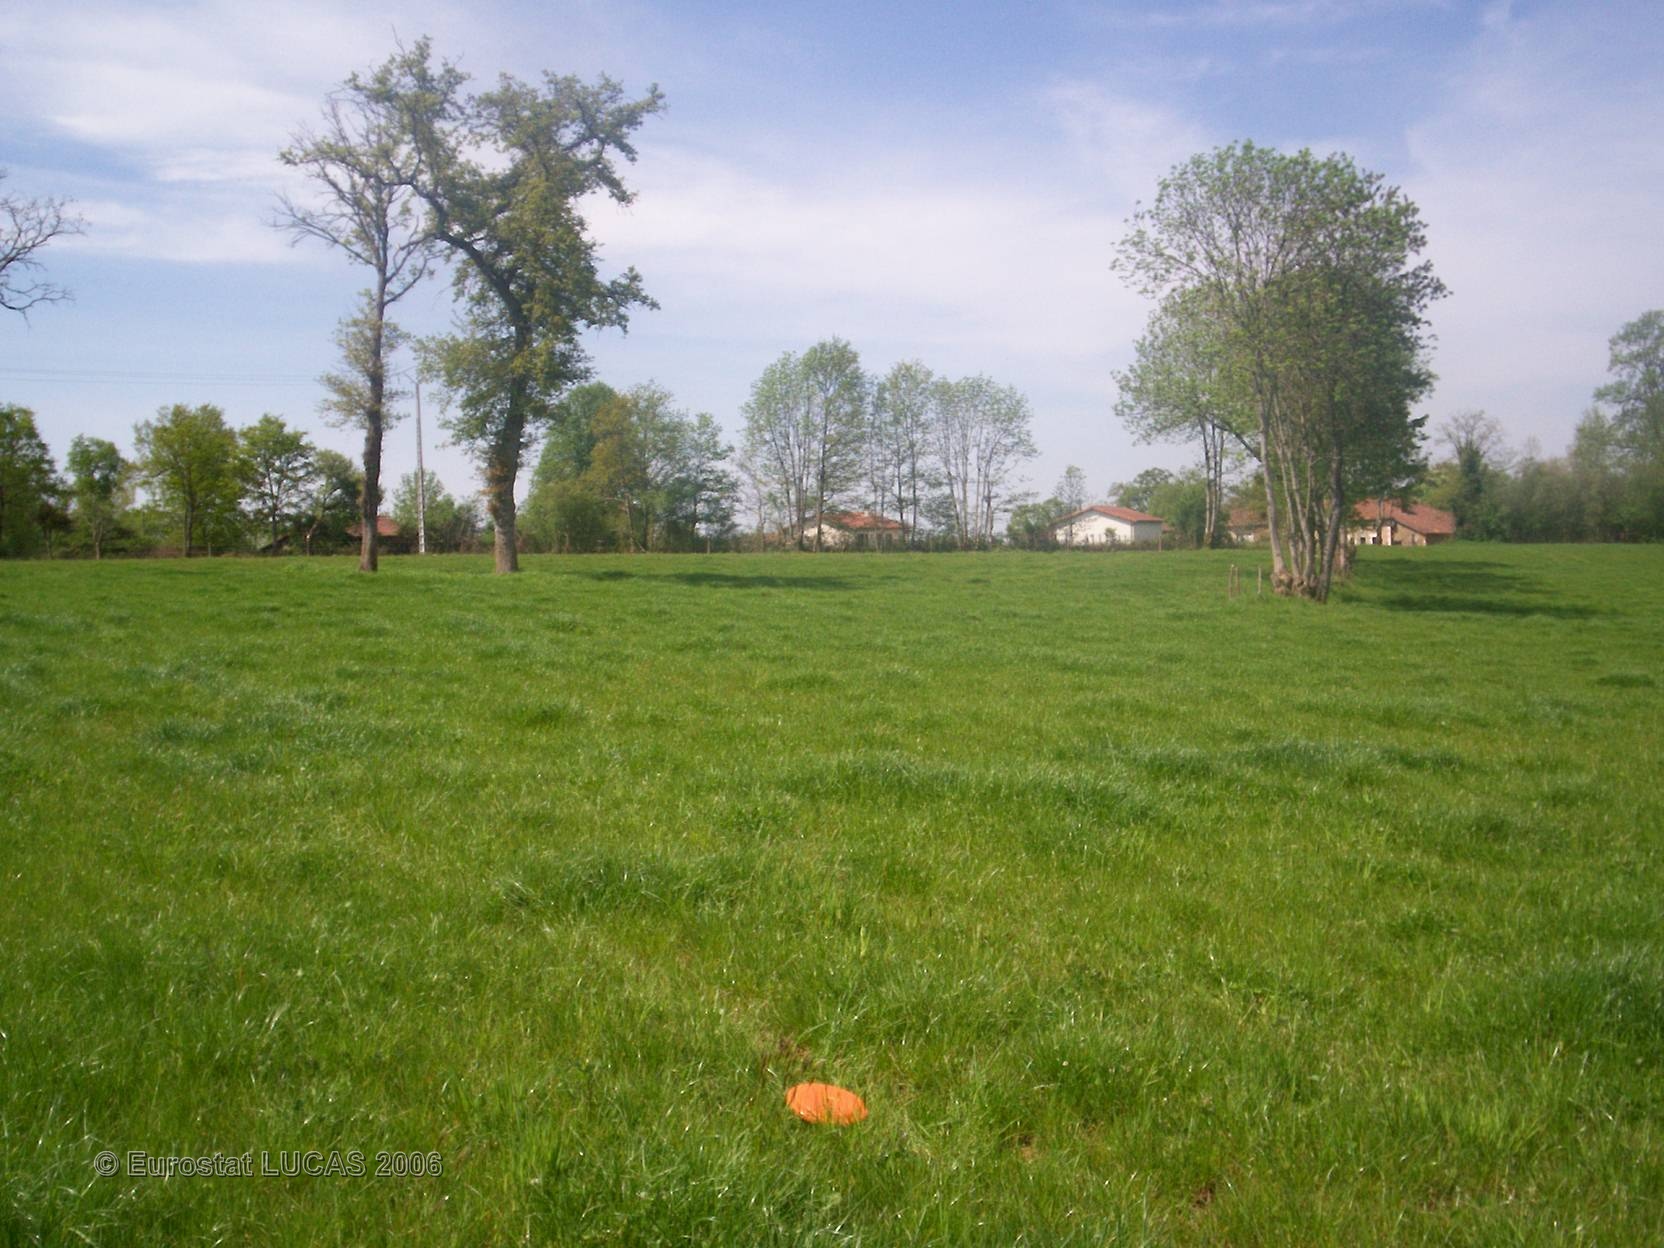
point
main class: Grassland
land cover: Grassland without tree/shrub cover
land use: Agriculture (excluding fallow land and kitchen gardens)
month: May
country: FR
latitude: 45.9775
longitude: 0.6541
